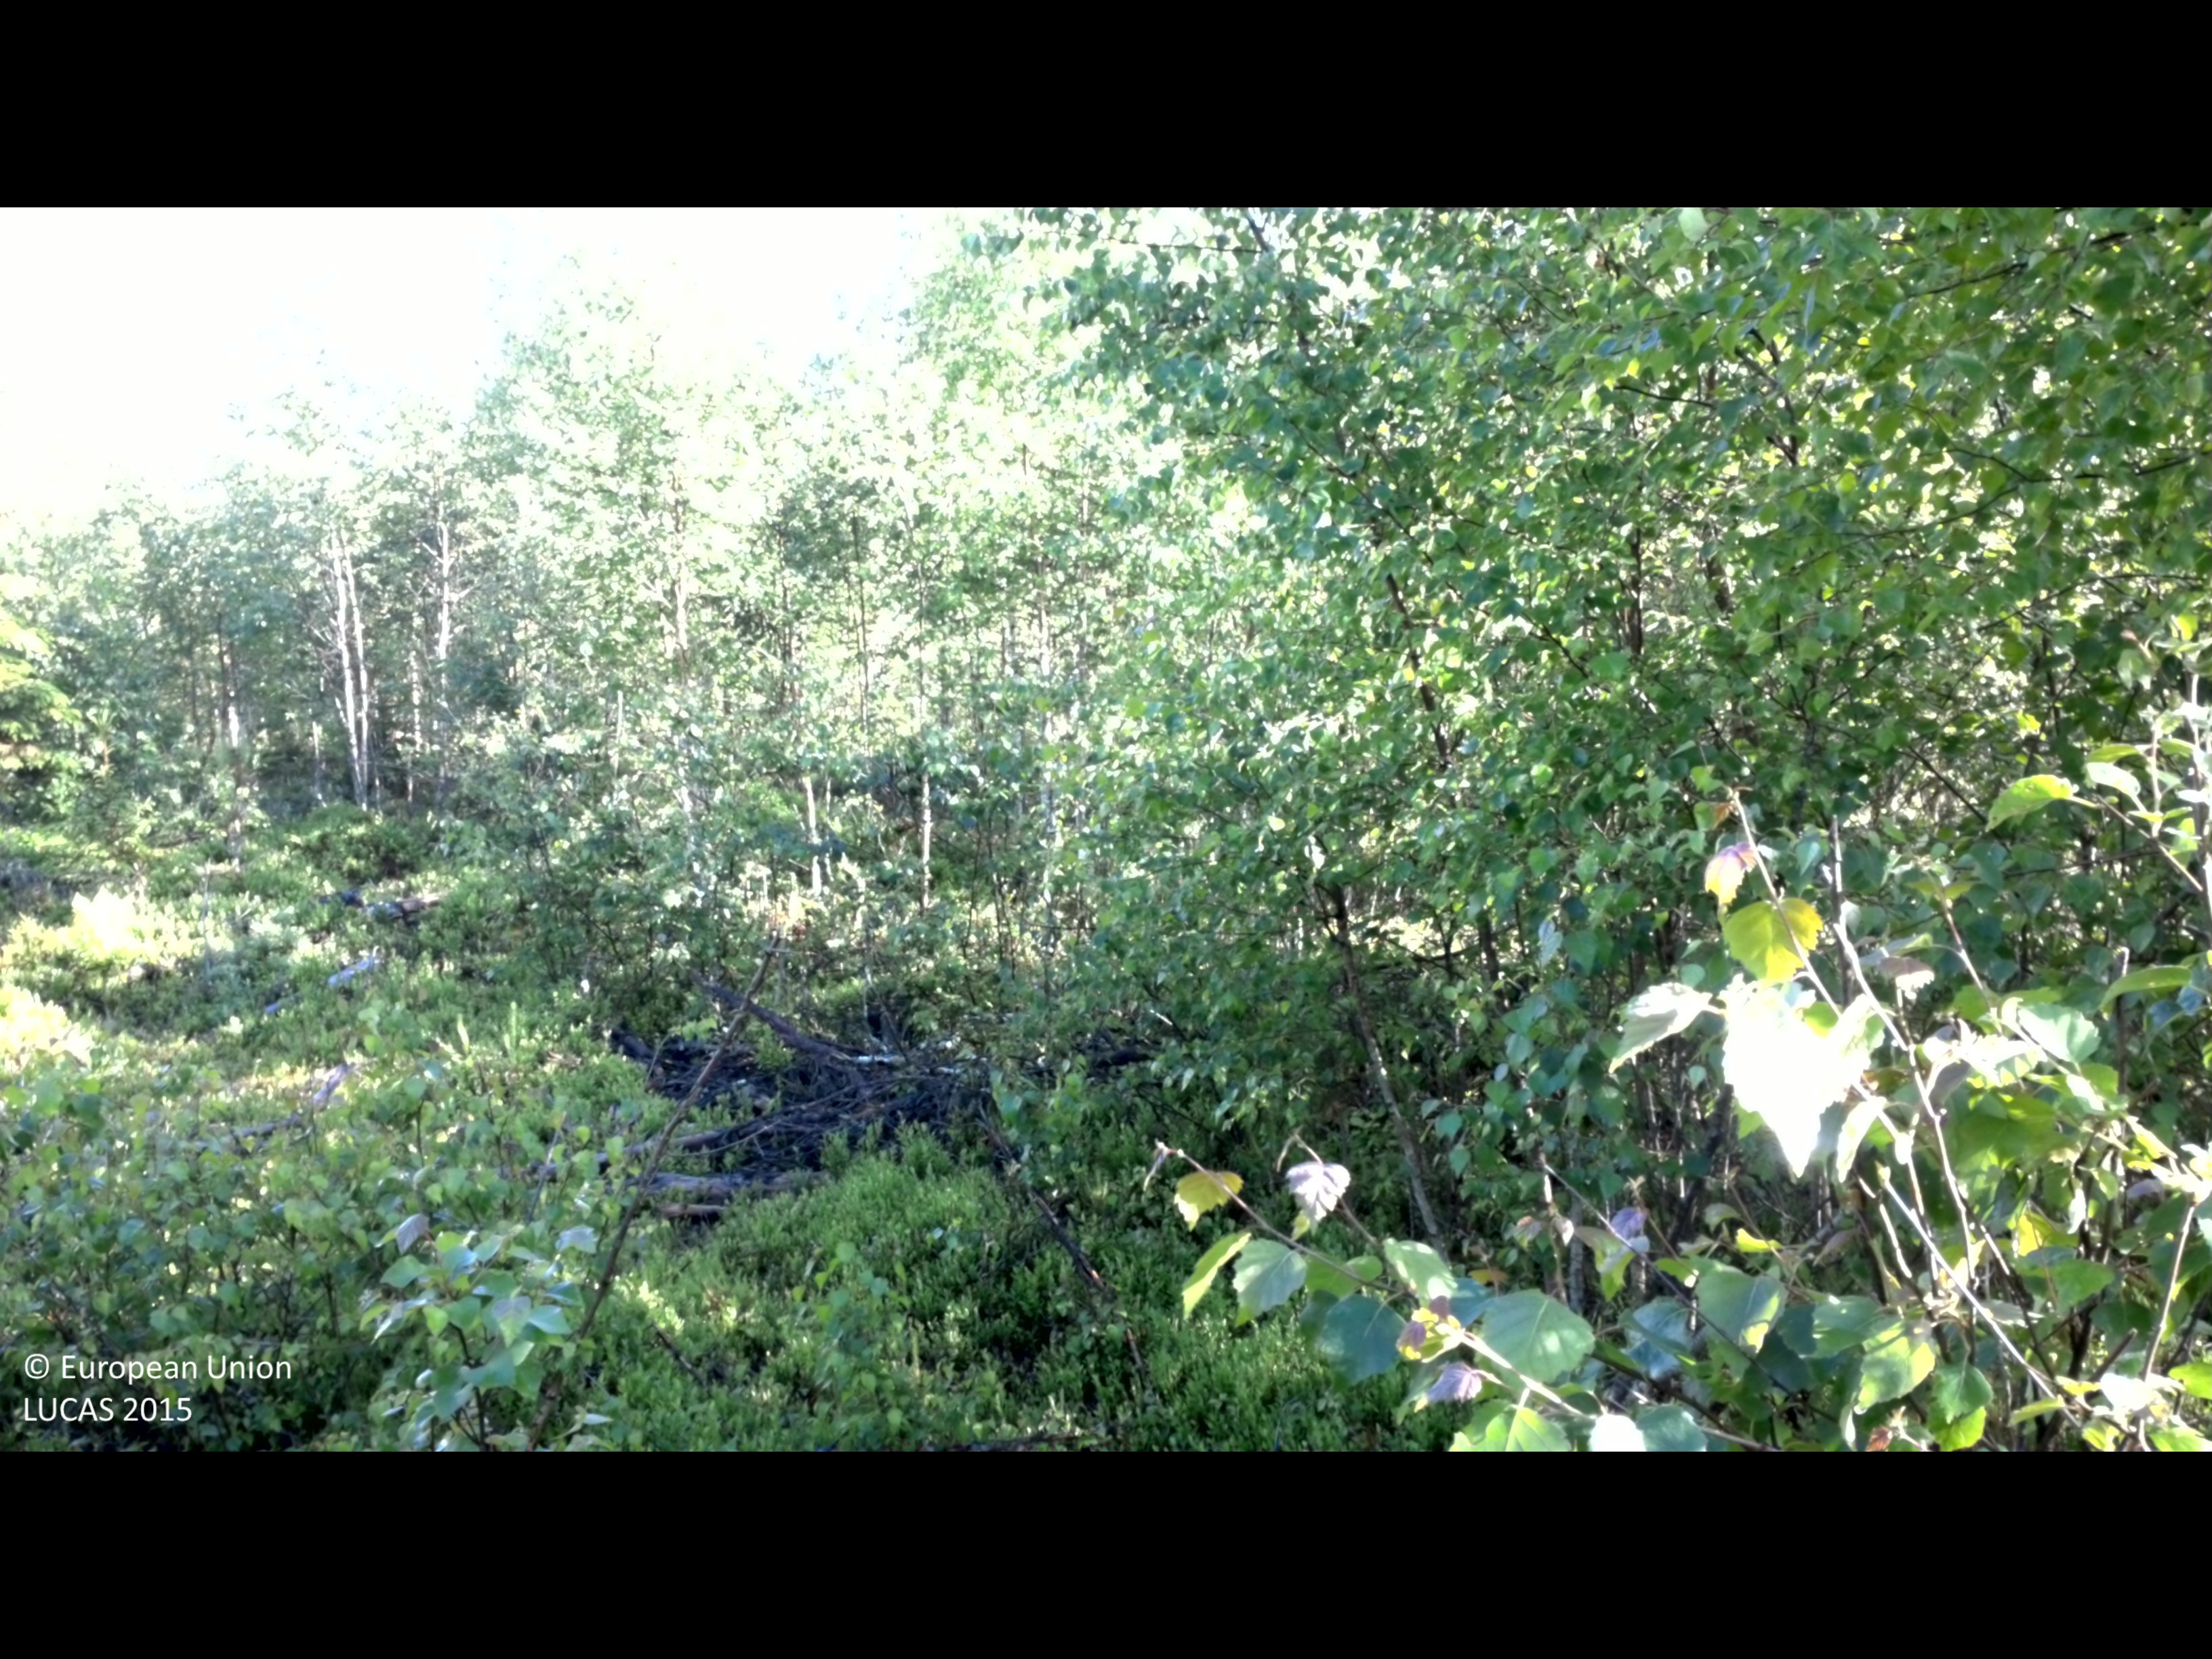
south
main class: Woodland
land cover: Broadleaved woodland
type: boreal forest
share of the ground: > 75 %
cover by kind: broadleaved forest trees 75 %, shrubs 25 %
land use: Forestry
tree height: < 5 m
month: June
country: SE
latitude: 58.1534
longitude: 16.0964
